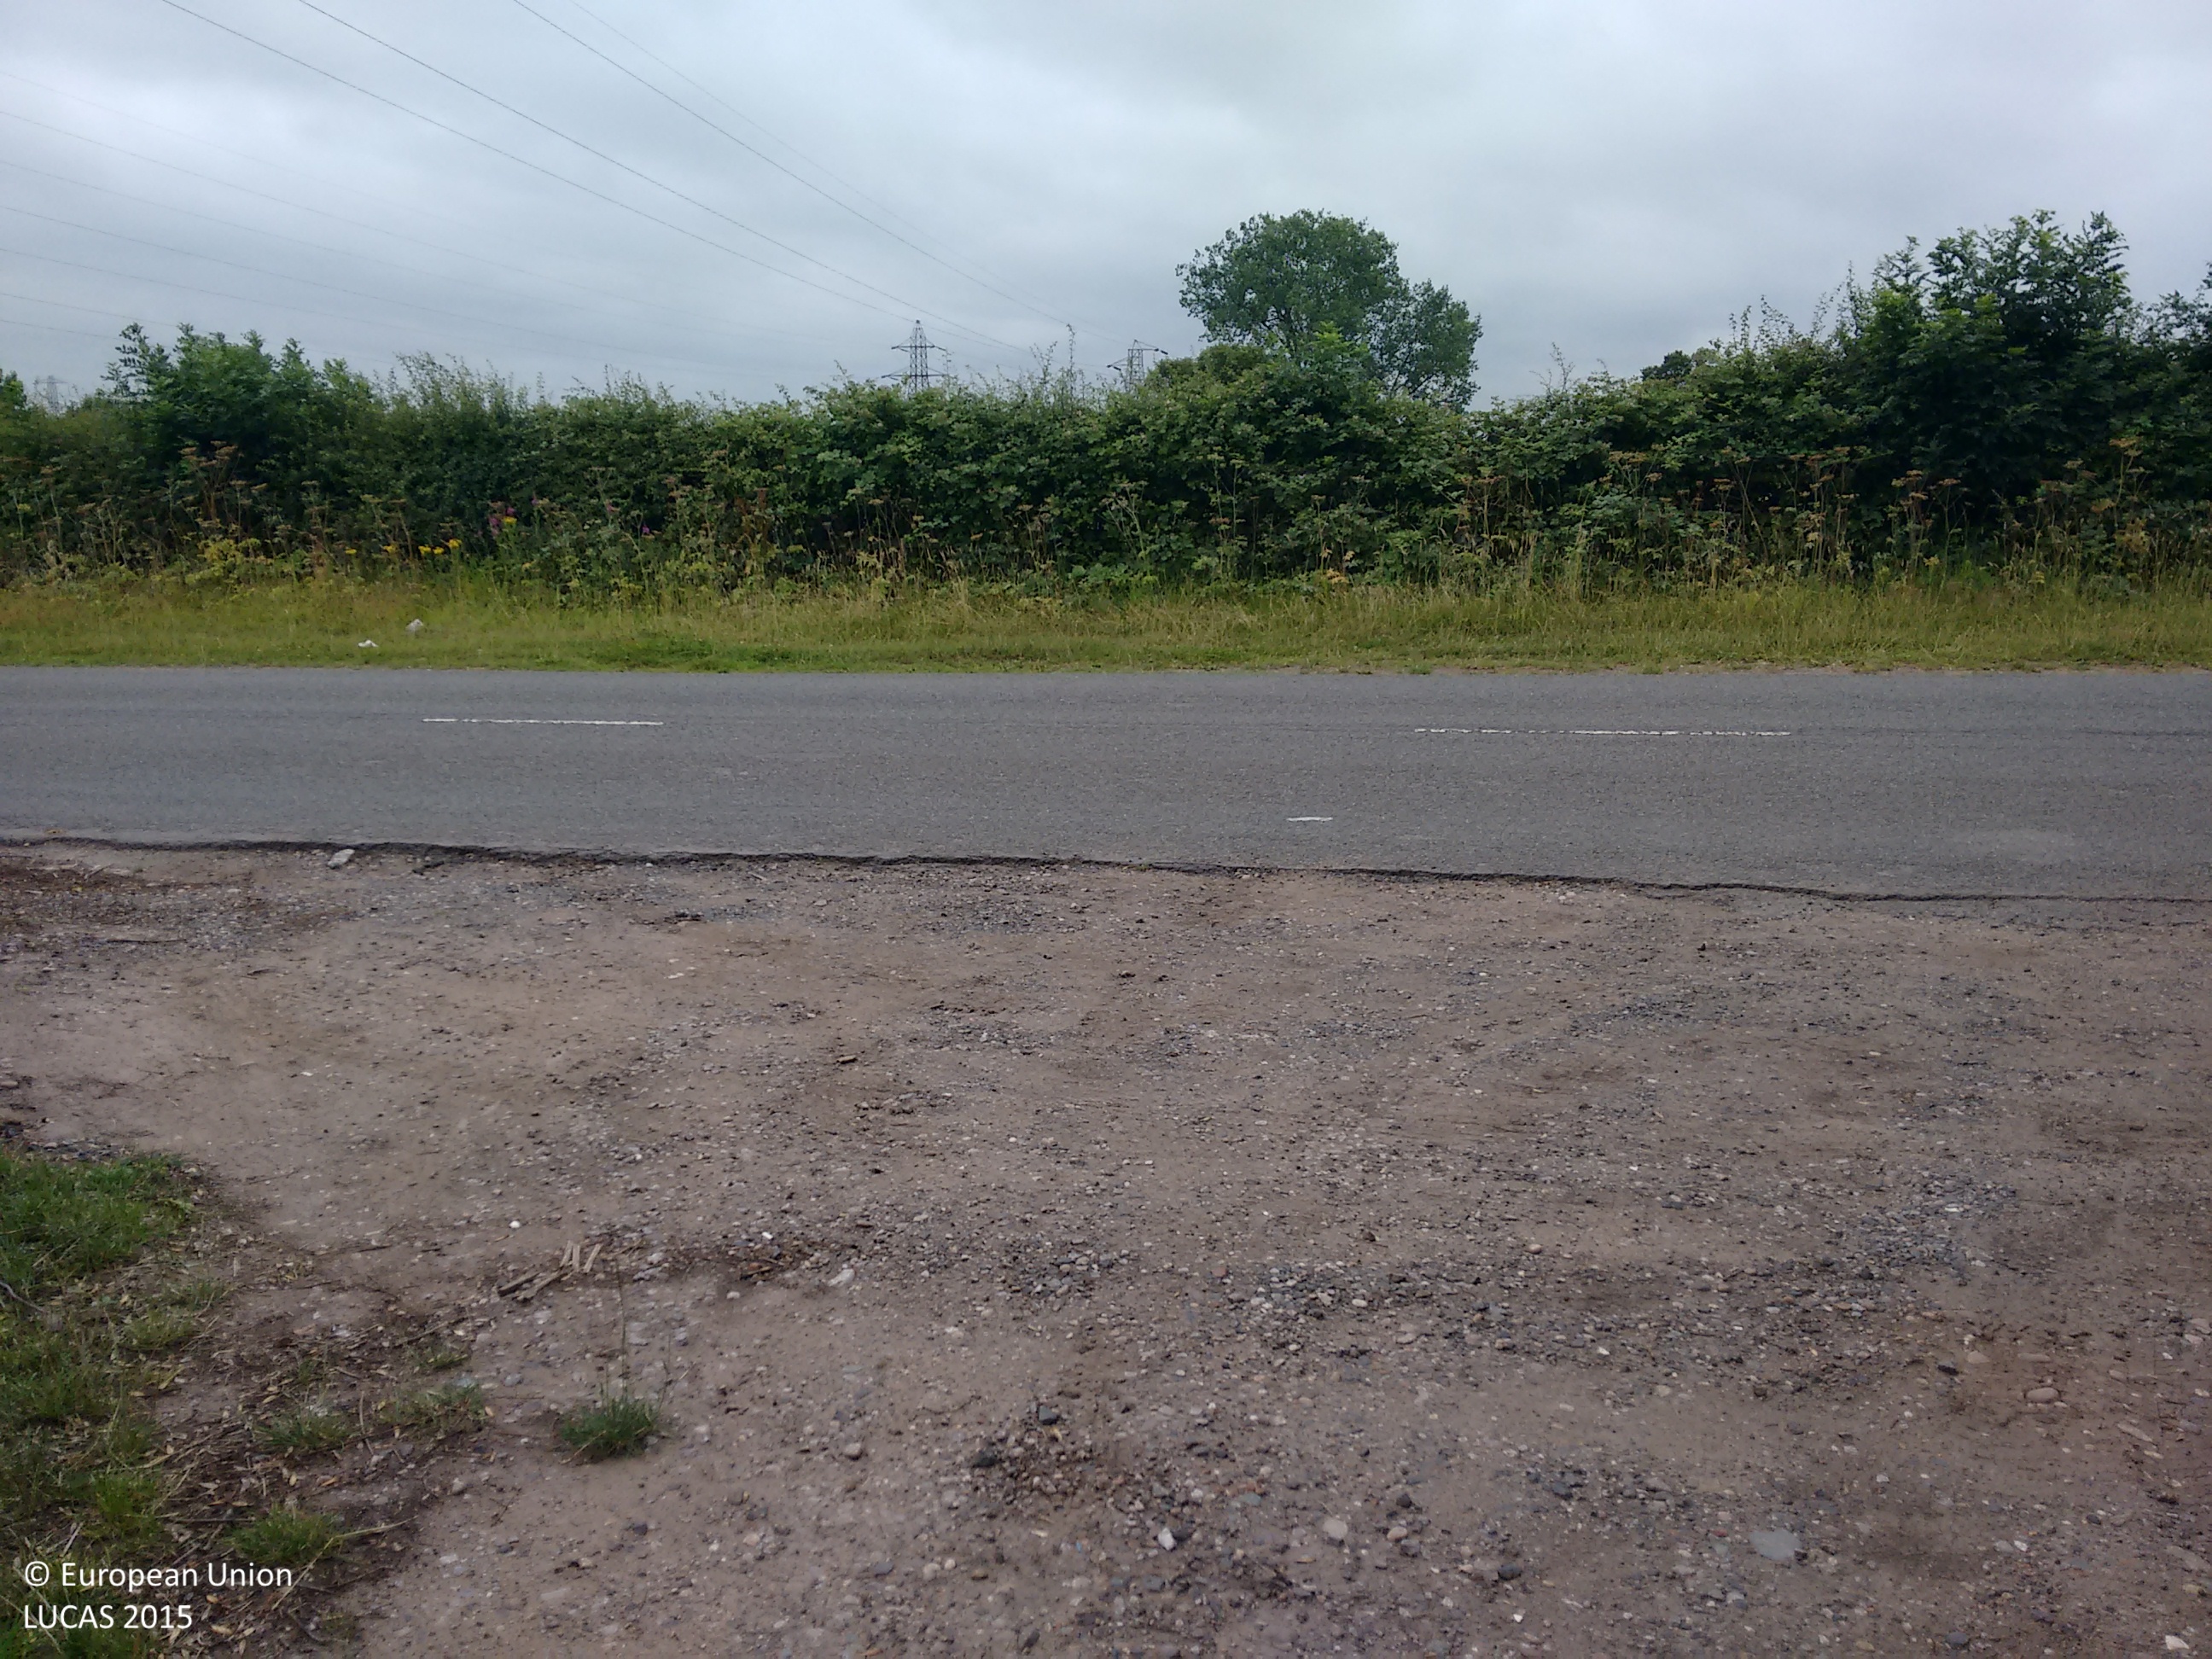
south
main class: Cropland
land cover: Maize
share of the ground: > 75 %
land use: Agriculture (excluding fallow land and kitchen gardens)
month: July
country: GB
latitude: 52.4309
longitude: -1.7173
